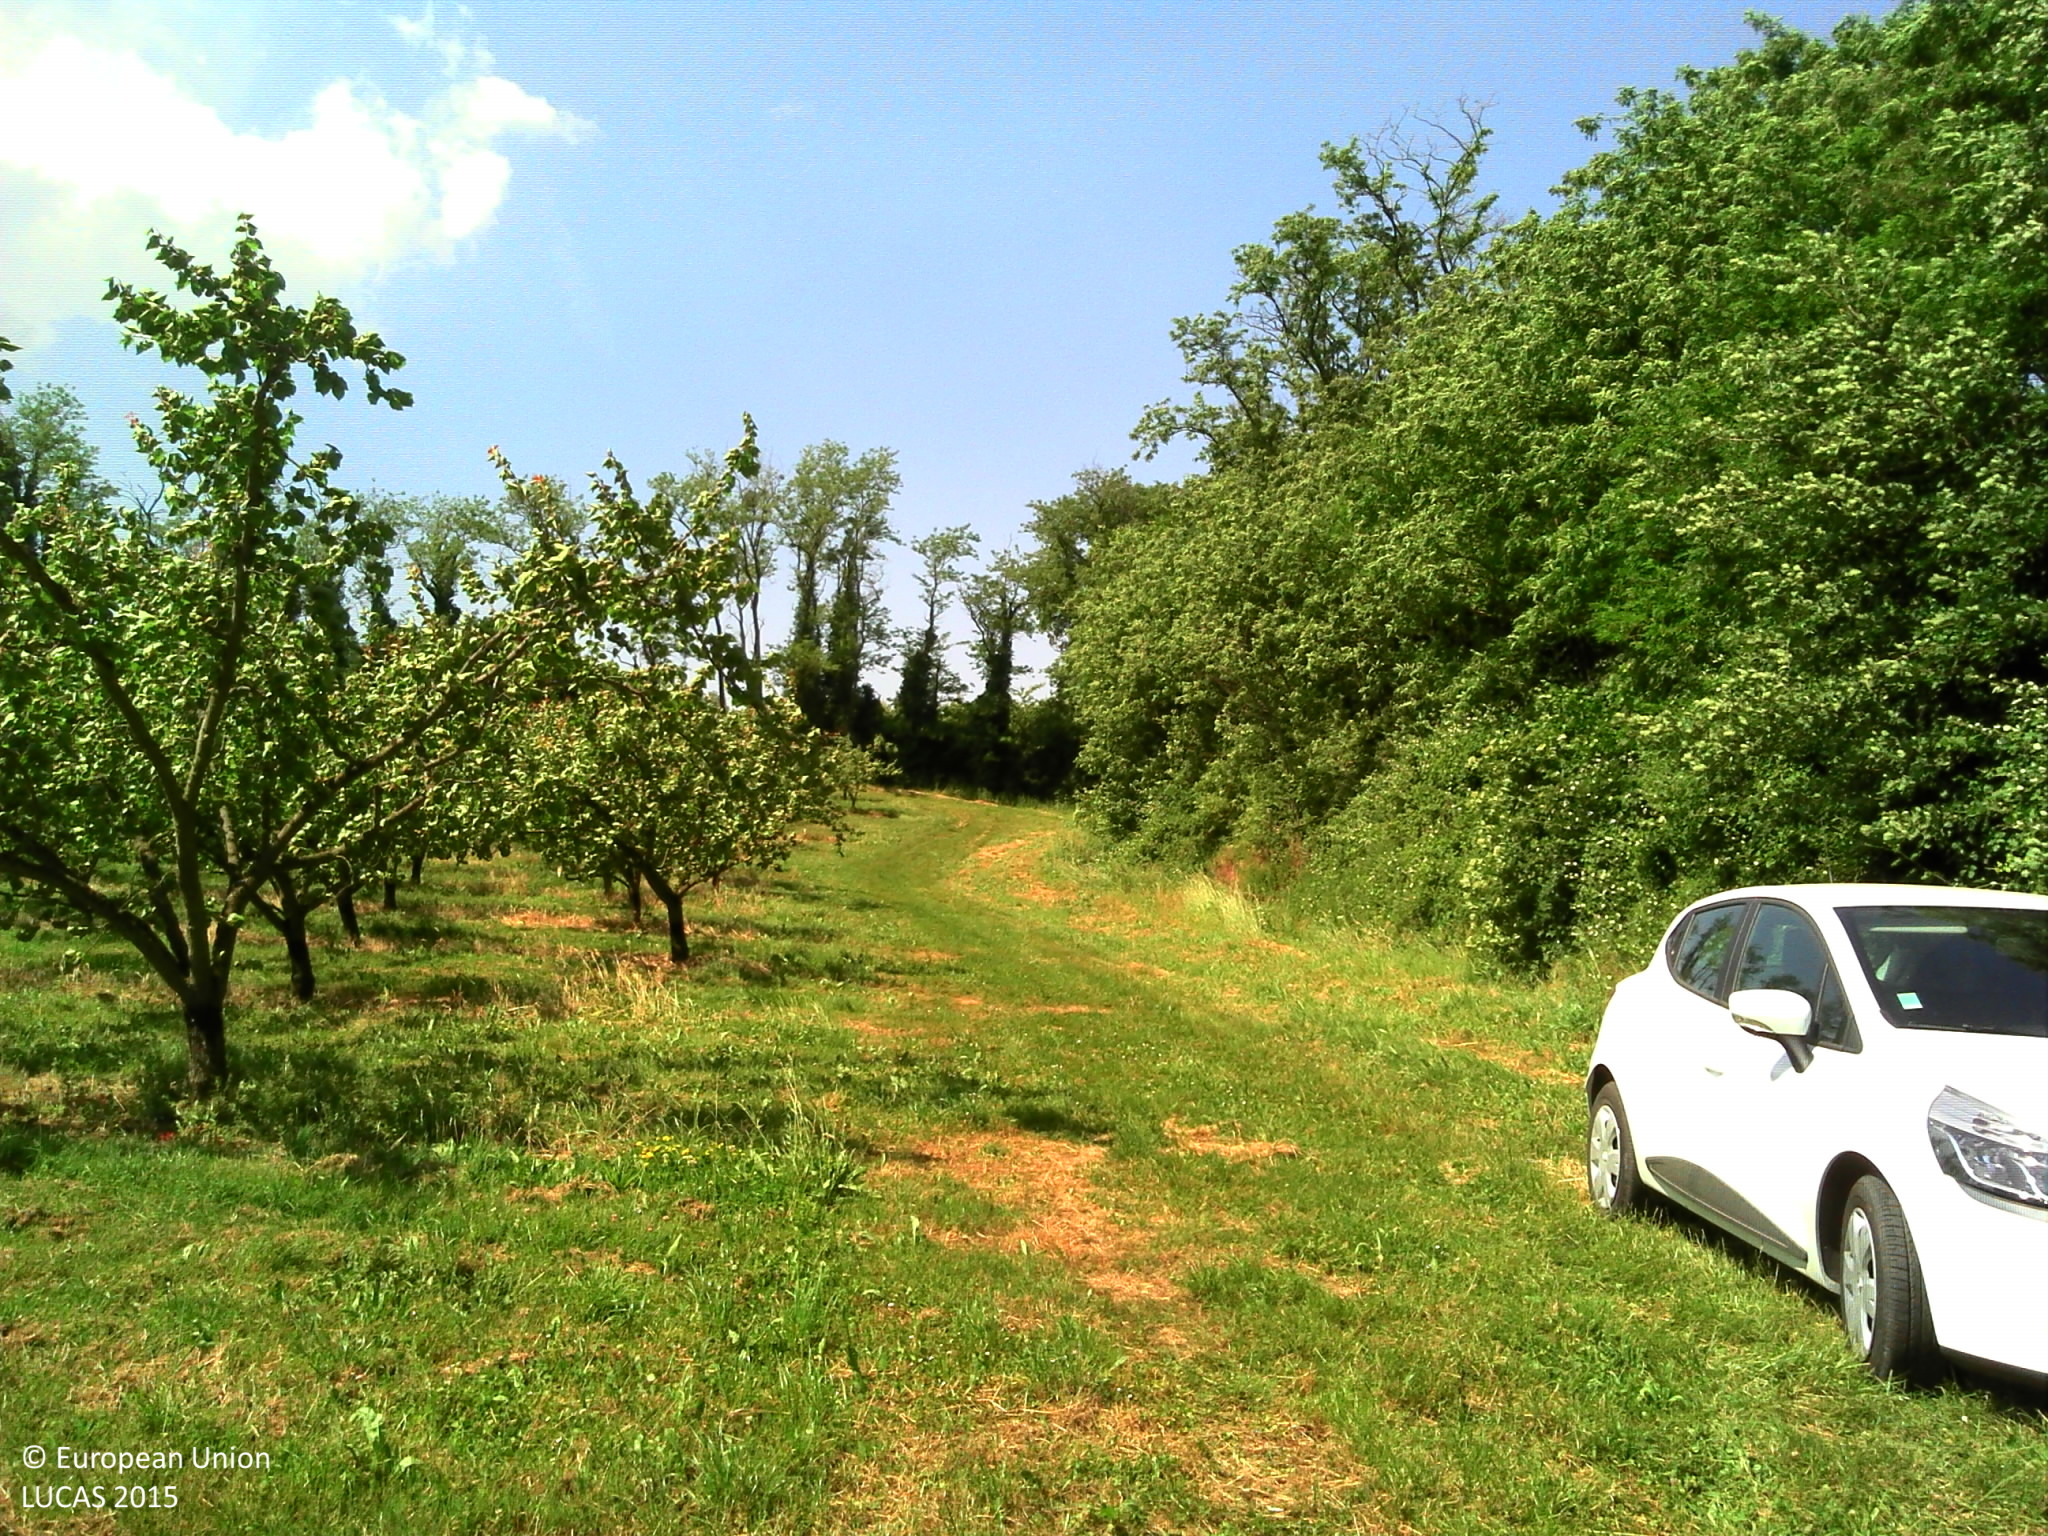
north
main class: Grassland
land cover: Grassland without tree/shrub cover
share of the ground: > 75 %
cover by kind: herbaceous plants 100 %
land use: Agriculture (excluding fallow land and kitchen gardens)
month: May
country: FR
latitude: 45.0748
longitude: 4.9117
